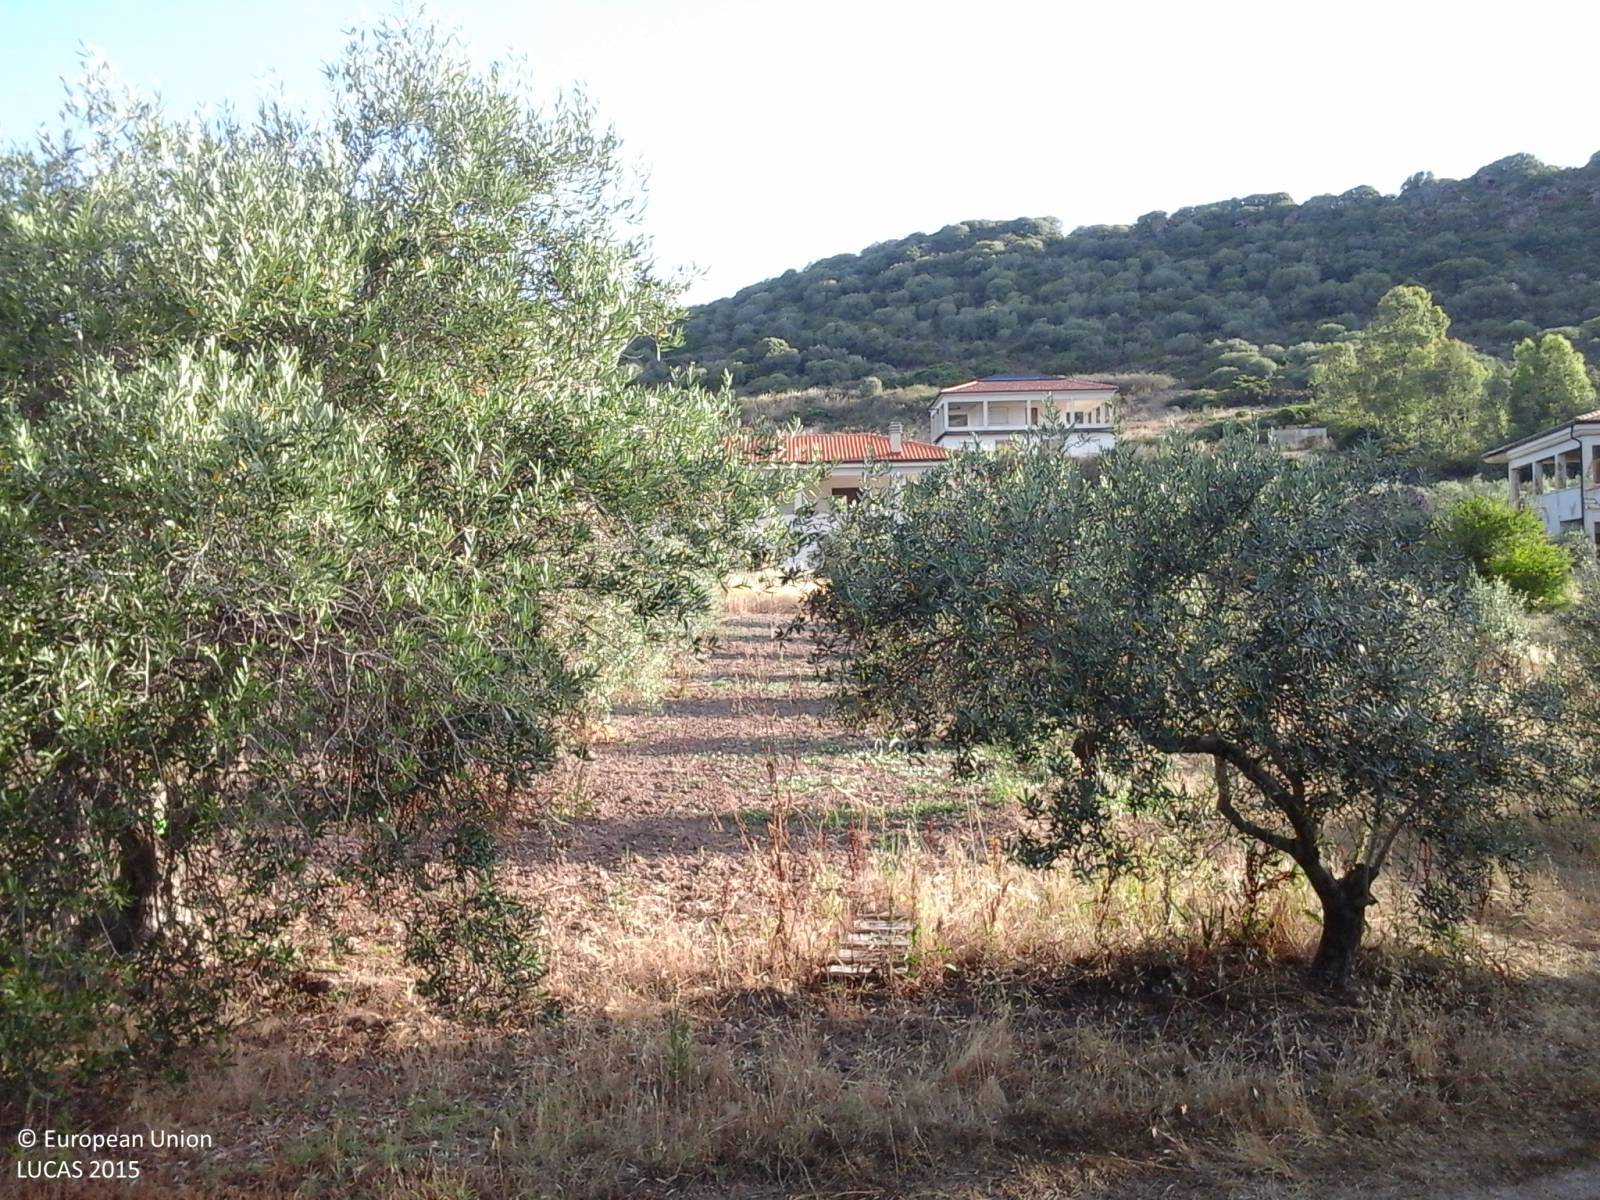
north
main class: Cropland
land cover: Olive groves
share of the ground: < 10 %
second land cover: Grassland without tree/shrub cover
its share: 50 - 75 %
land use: Agriculture (excluding fallow land and kitchen gardens)
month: June
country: IT
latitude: 40.5800
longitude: 8.3894
